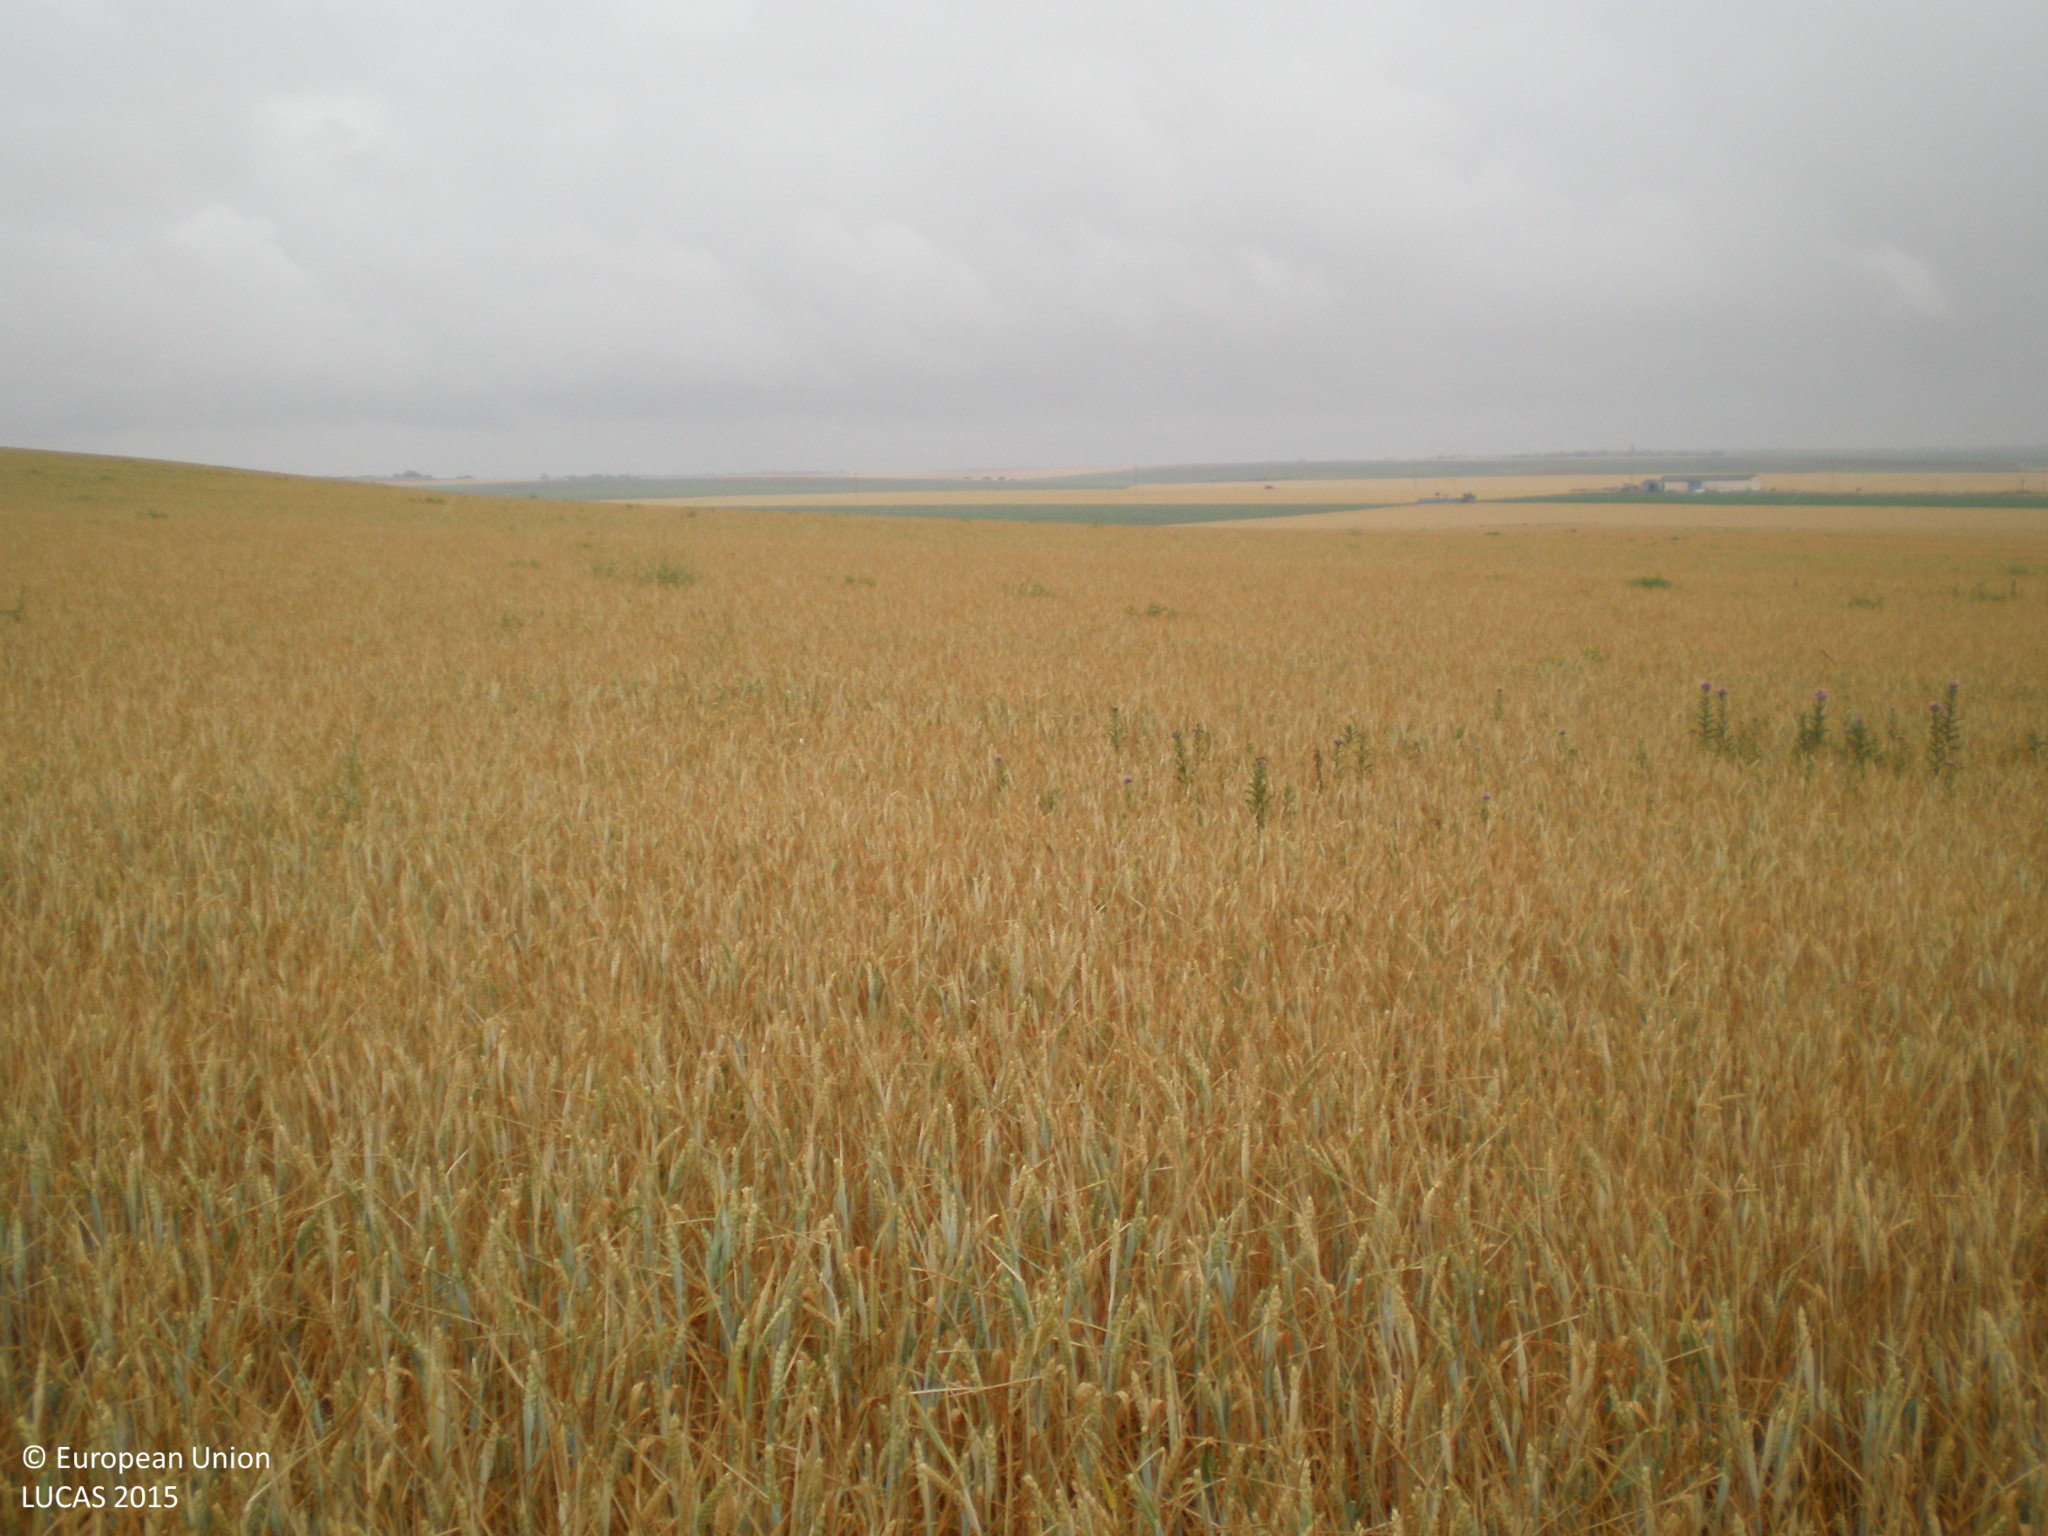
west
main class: Cropland
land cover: Common wheat
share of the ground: > 75 %
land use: Agriculture (excluding fallow land and kitchen gardens)
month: June
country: ES
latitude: 40.9714
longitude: -5.7532
